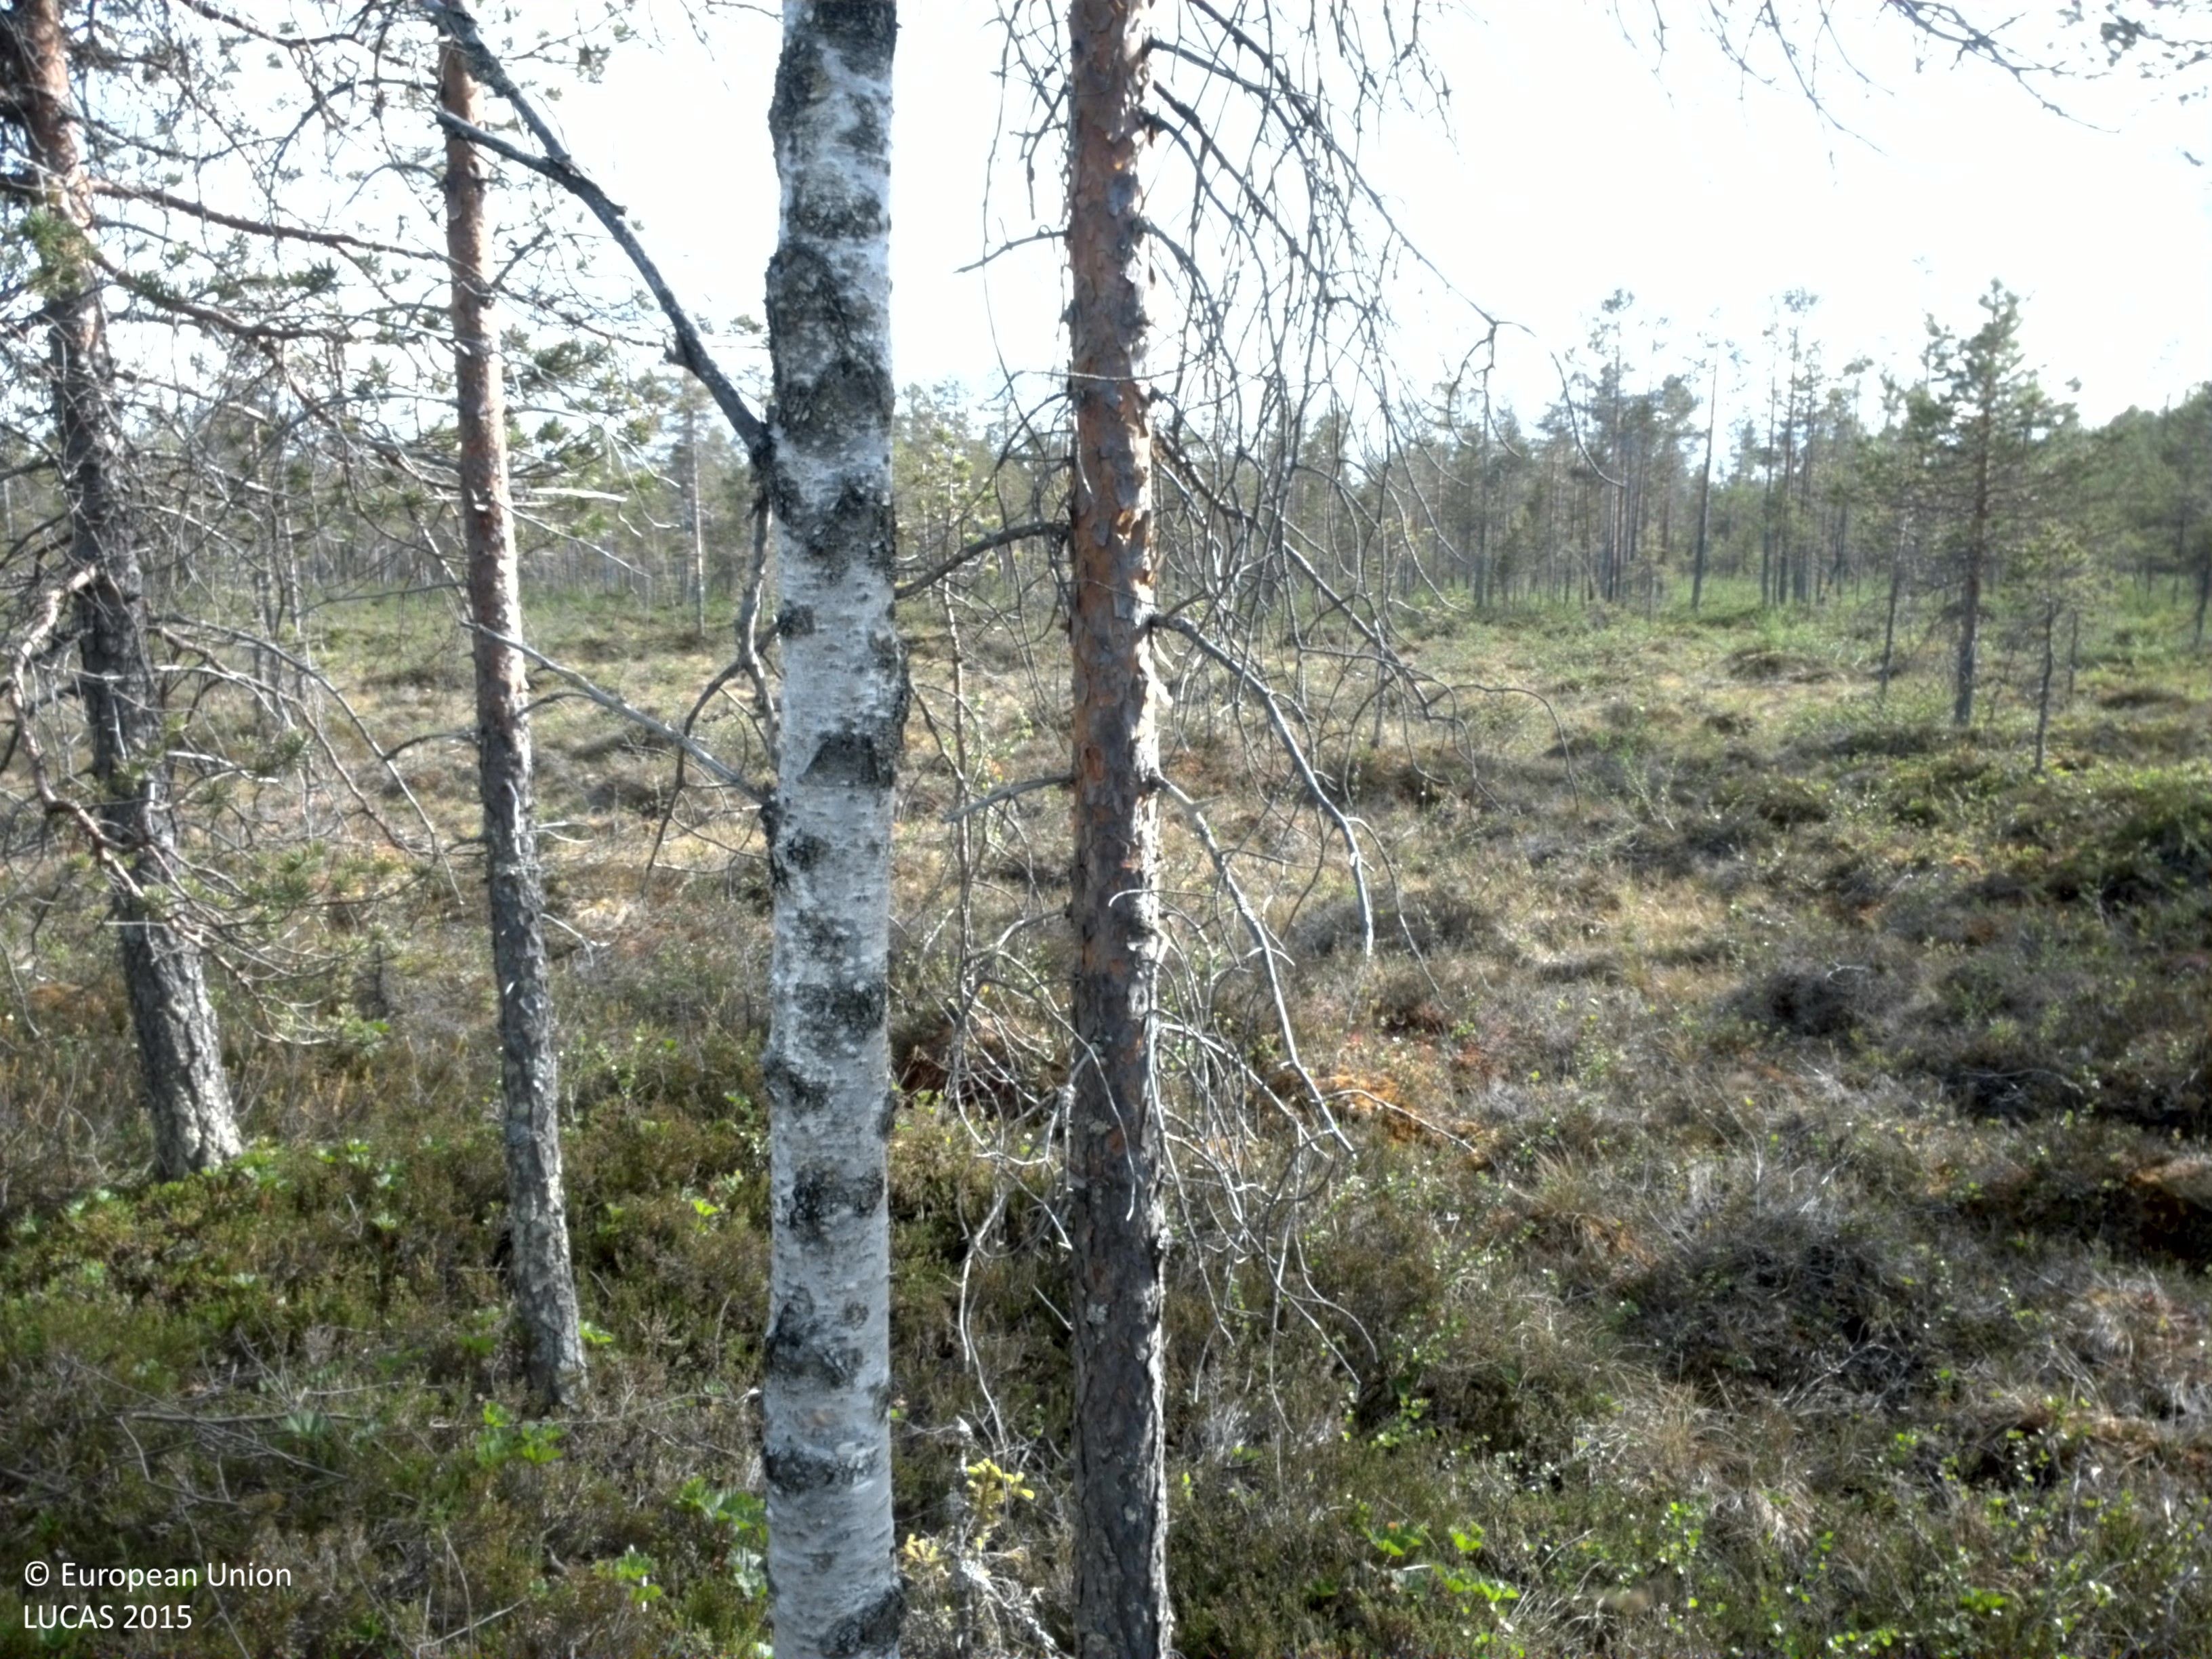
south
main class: Woodland
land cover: Pine dominated coniferous woodland
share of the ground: 10 - 25 %
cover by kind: shrubs 85 %, coniferous forest trees 15 %
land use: Semi-natural and natural areas not in use
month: June
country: SE
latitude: 66.2731
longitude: 22.6940
